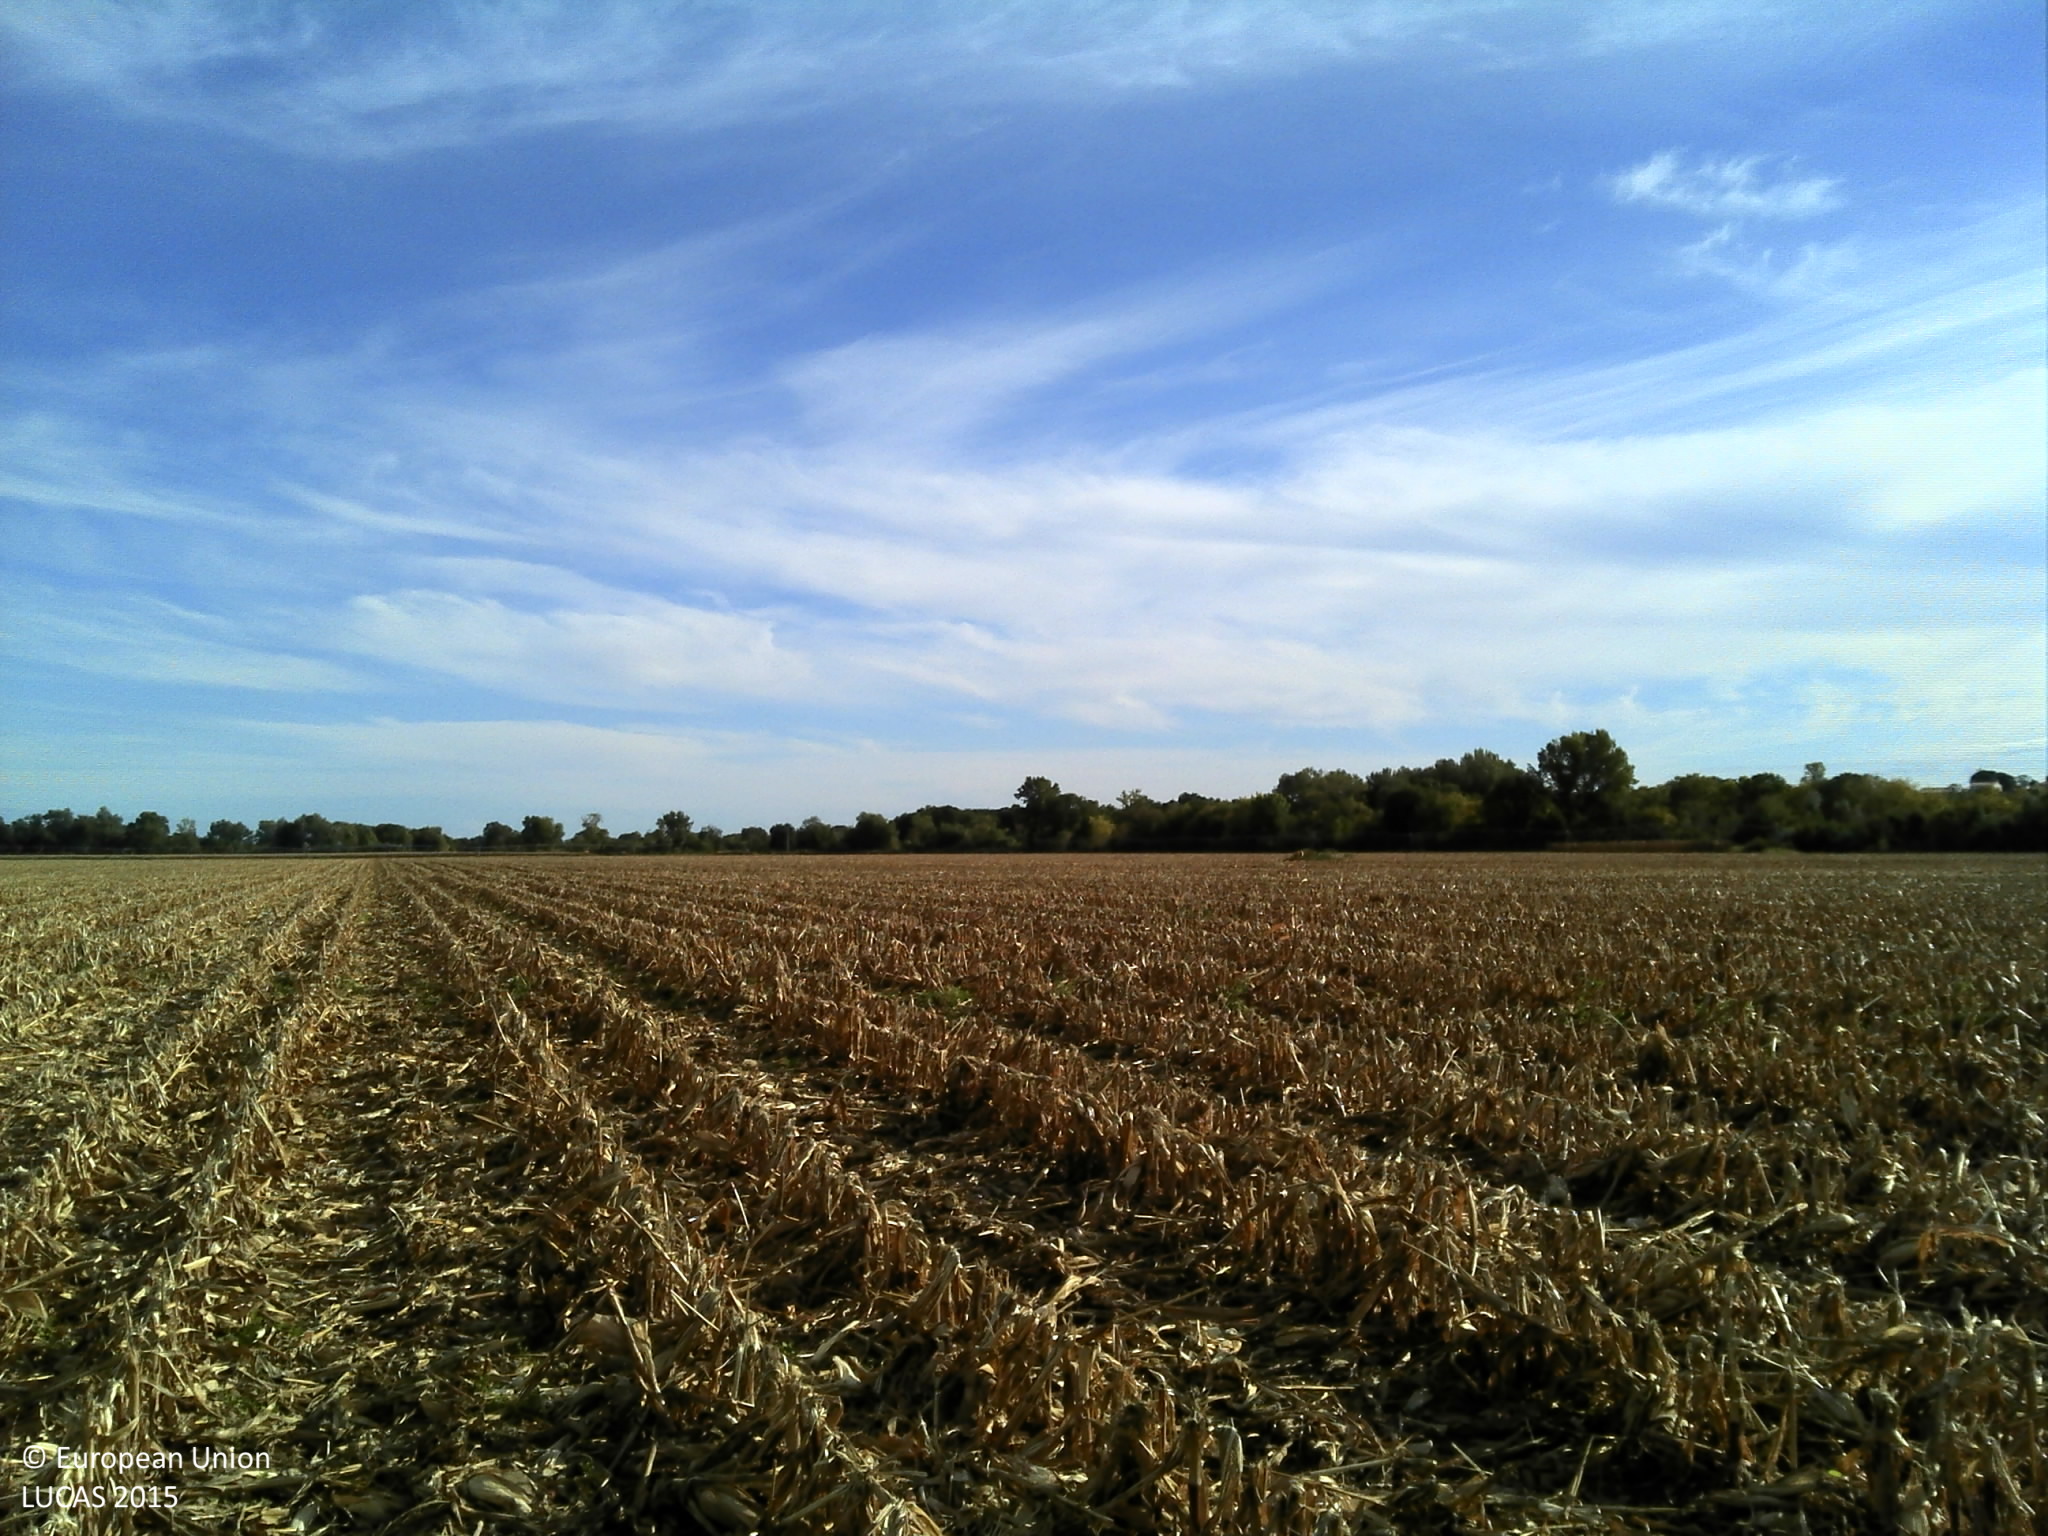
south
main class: Cropland
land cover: Maize
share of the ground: 50 - 75 %
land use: Agriculture (excluding fallow land and kitchen gardens)
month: October
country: FR
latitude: 43.4002
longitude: 3.4285
